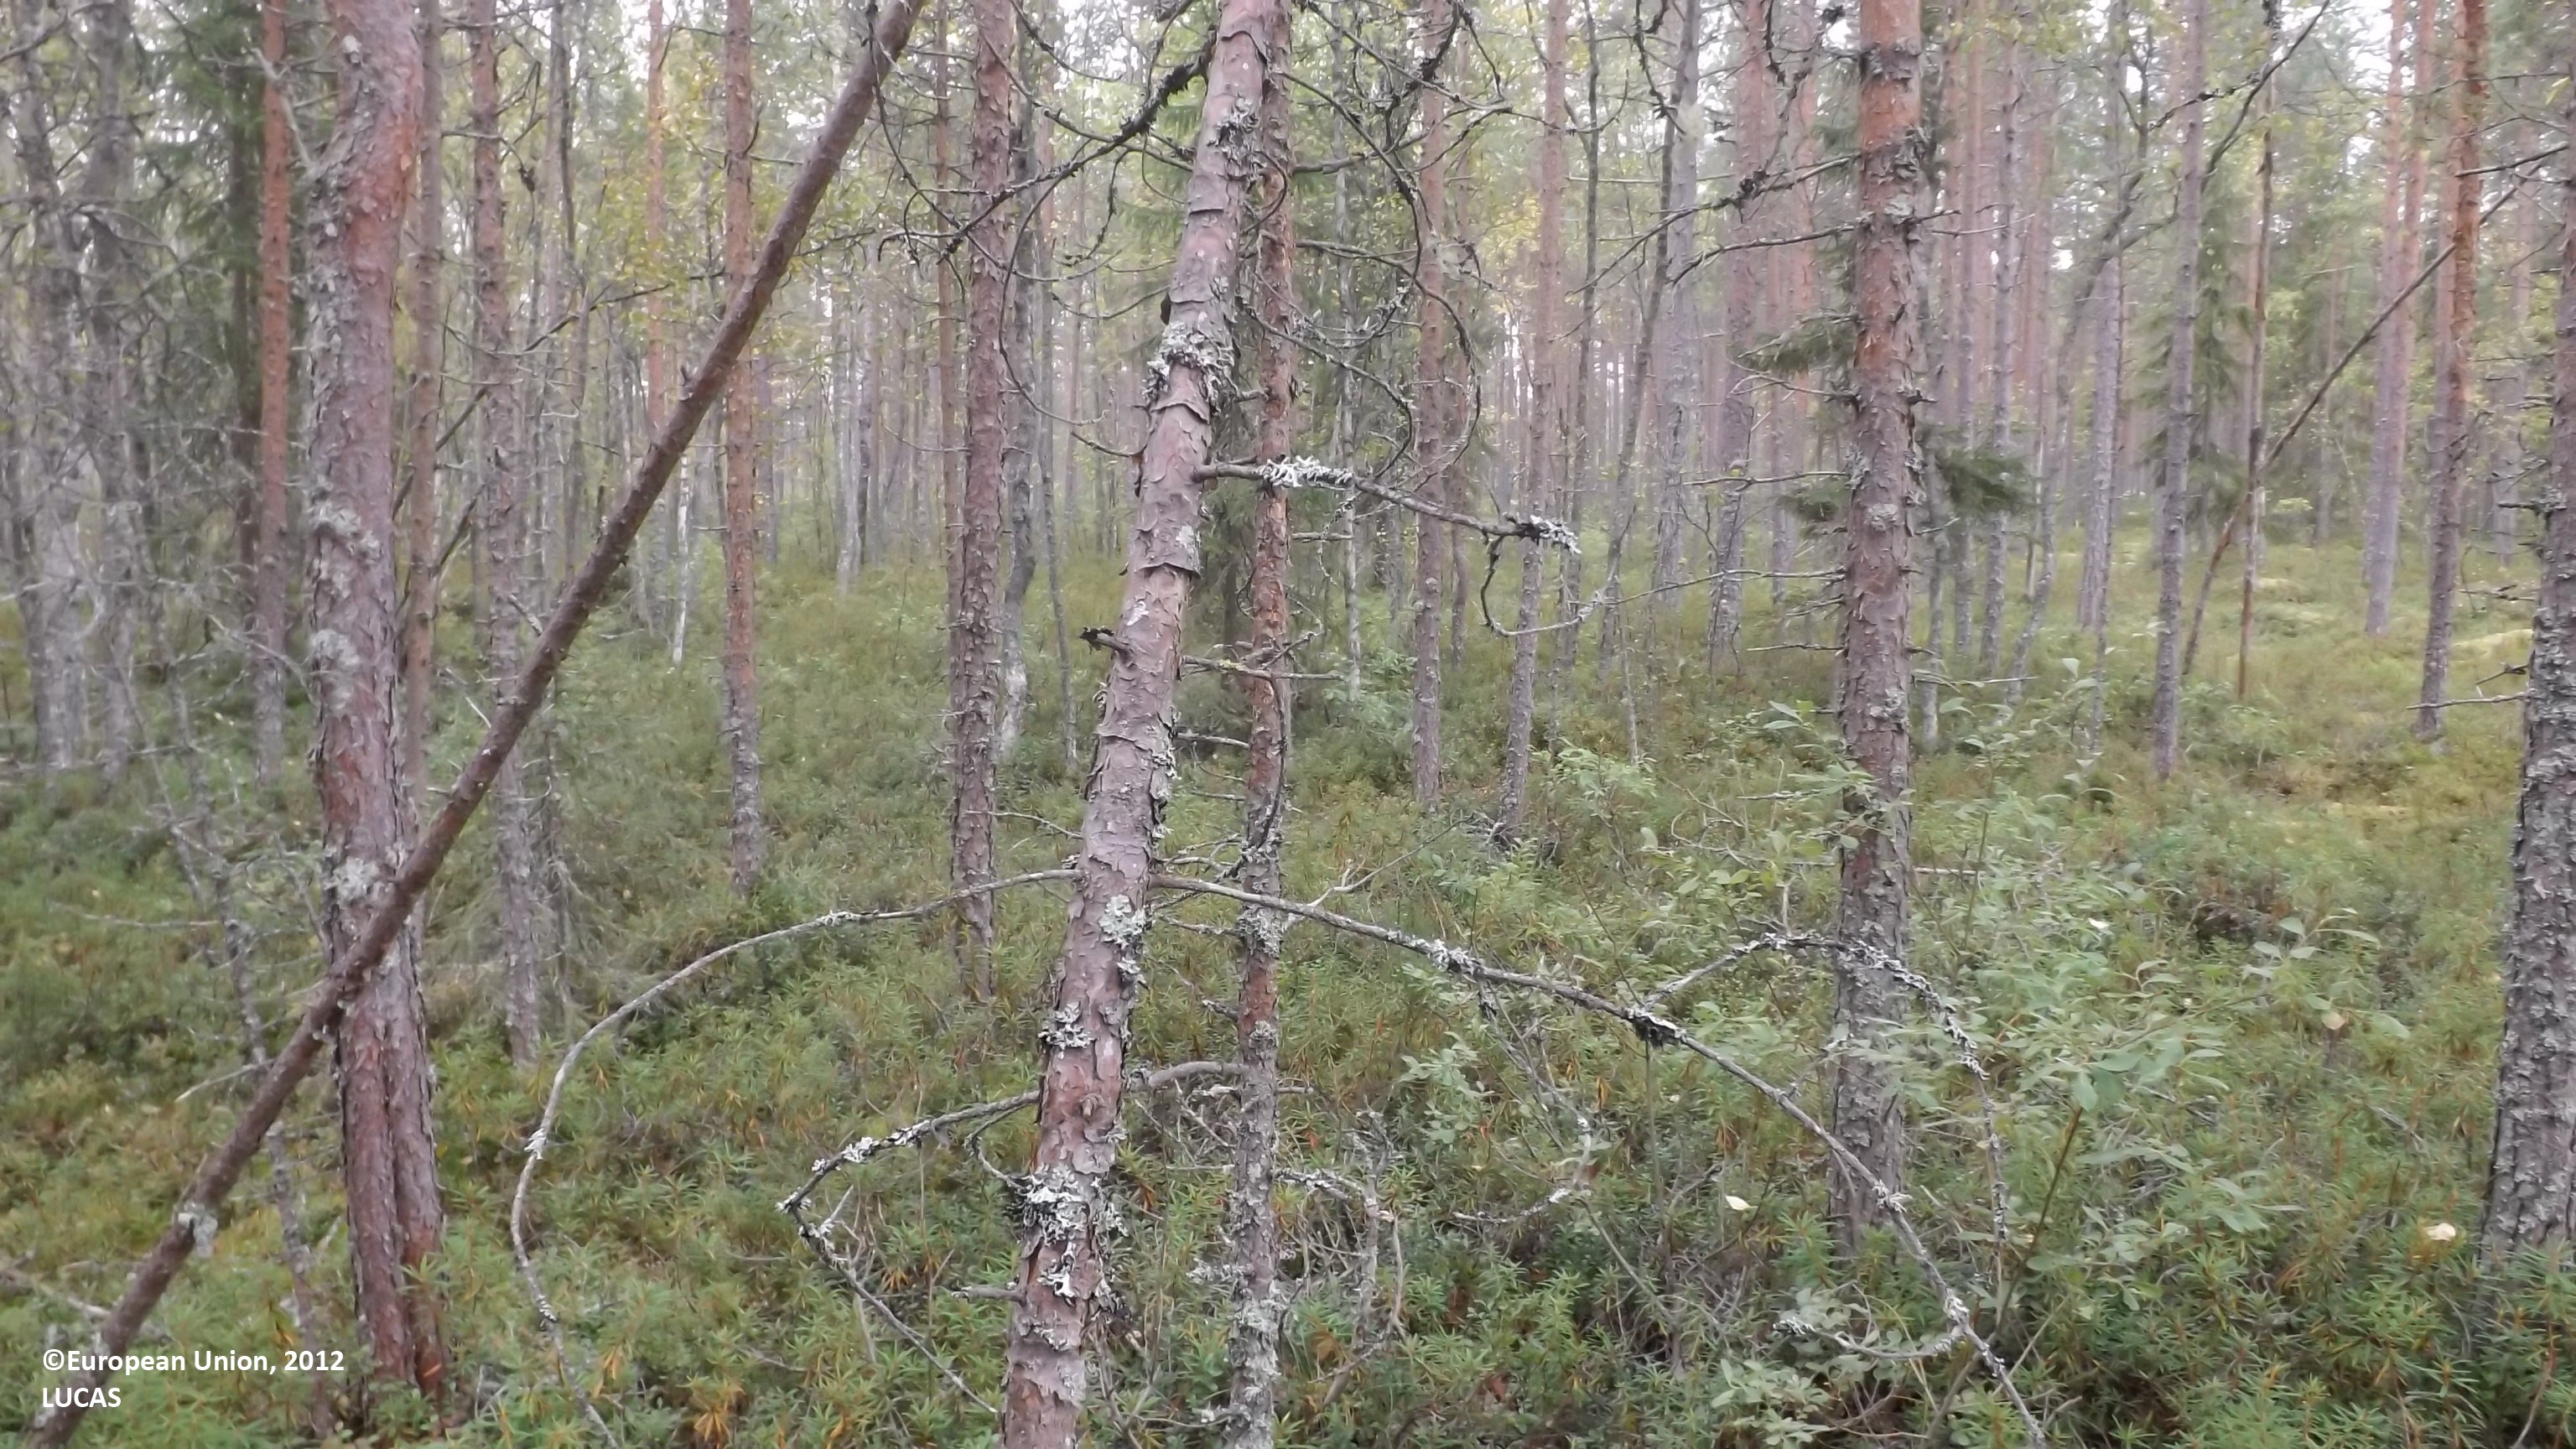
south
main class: Woodland
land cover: Pine dominated mixed woodland
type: boreal forest
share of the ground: 50 - 75 %
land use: Forestry
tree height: > 5 m
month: August
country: FI
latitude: 63.7981
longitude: 23.5179
